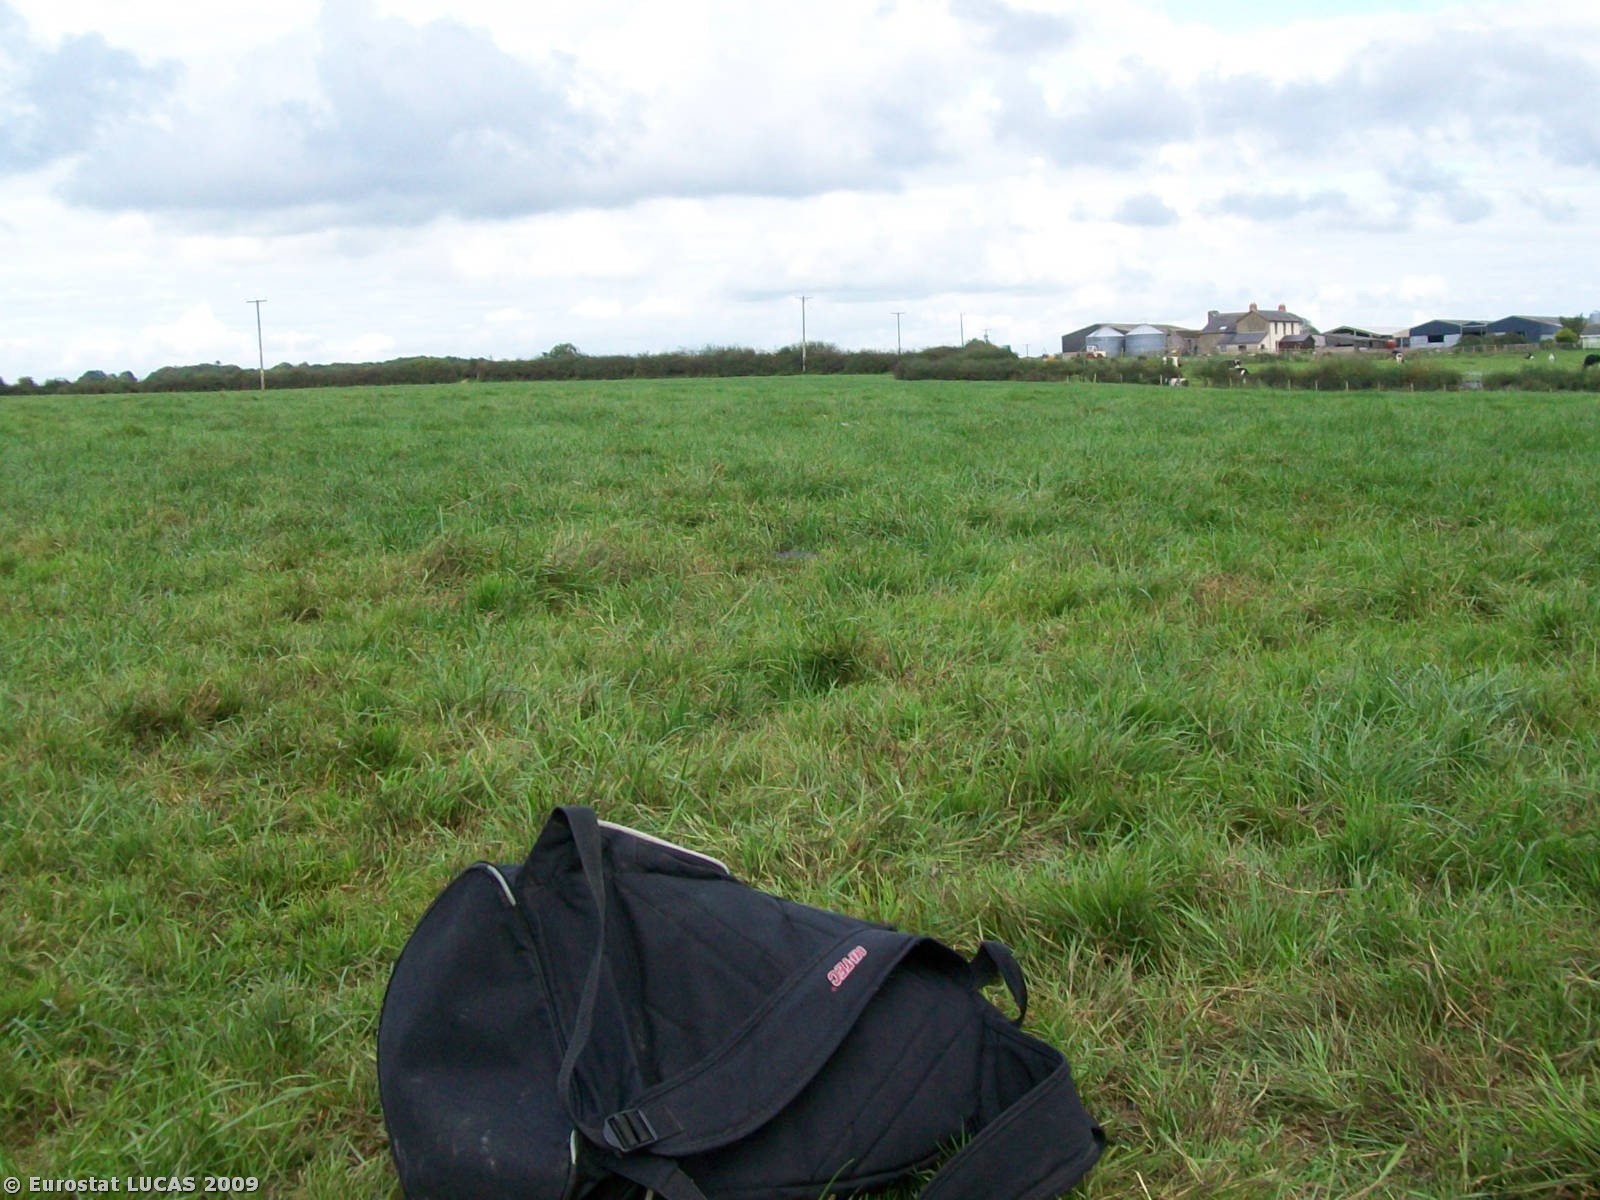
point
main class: Grassland
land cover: Grassland without tree/shrub cover
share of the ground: > 75 %
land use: Agriculture (excluding fallow land and kitchen gardens)
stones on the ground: < 10 %
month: October
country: GB
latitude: 51.8363
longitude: -4.7250
